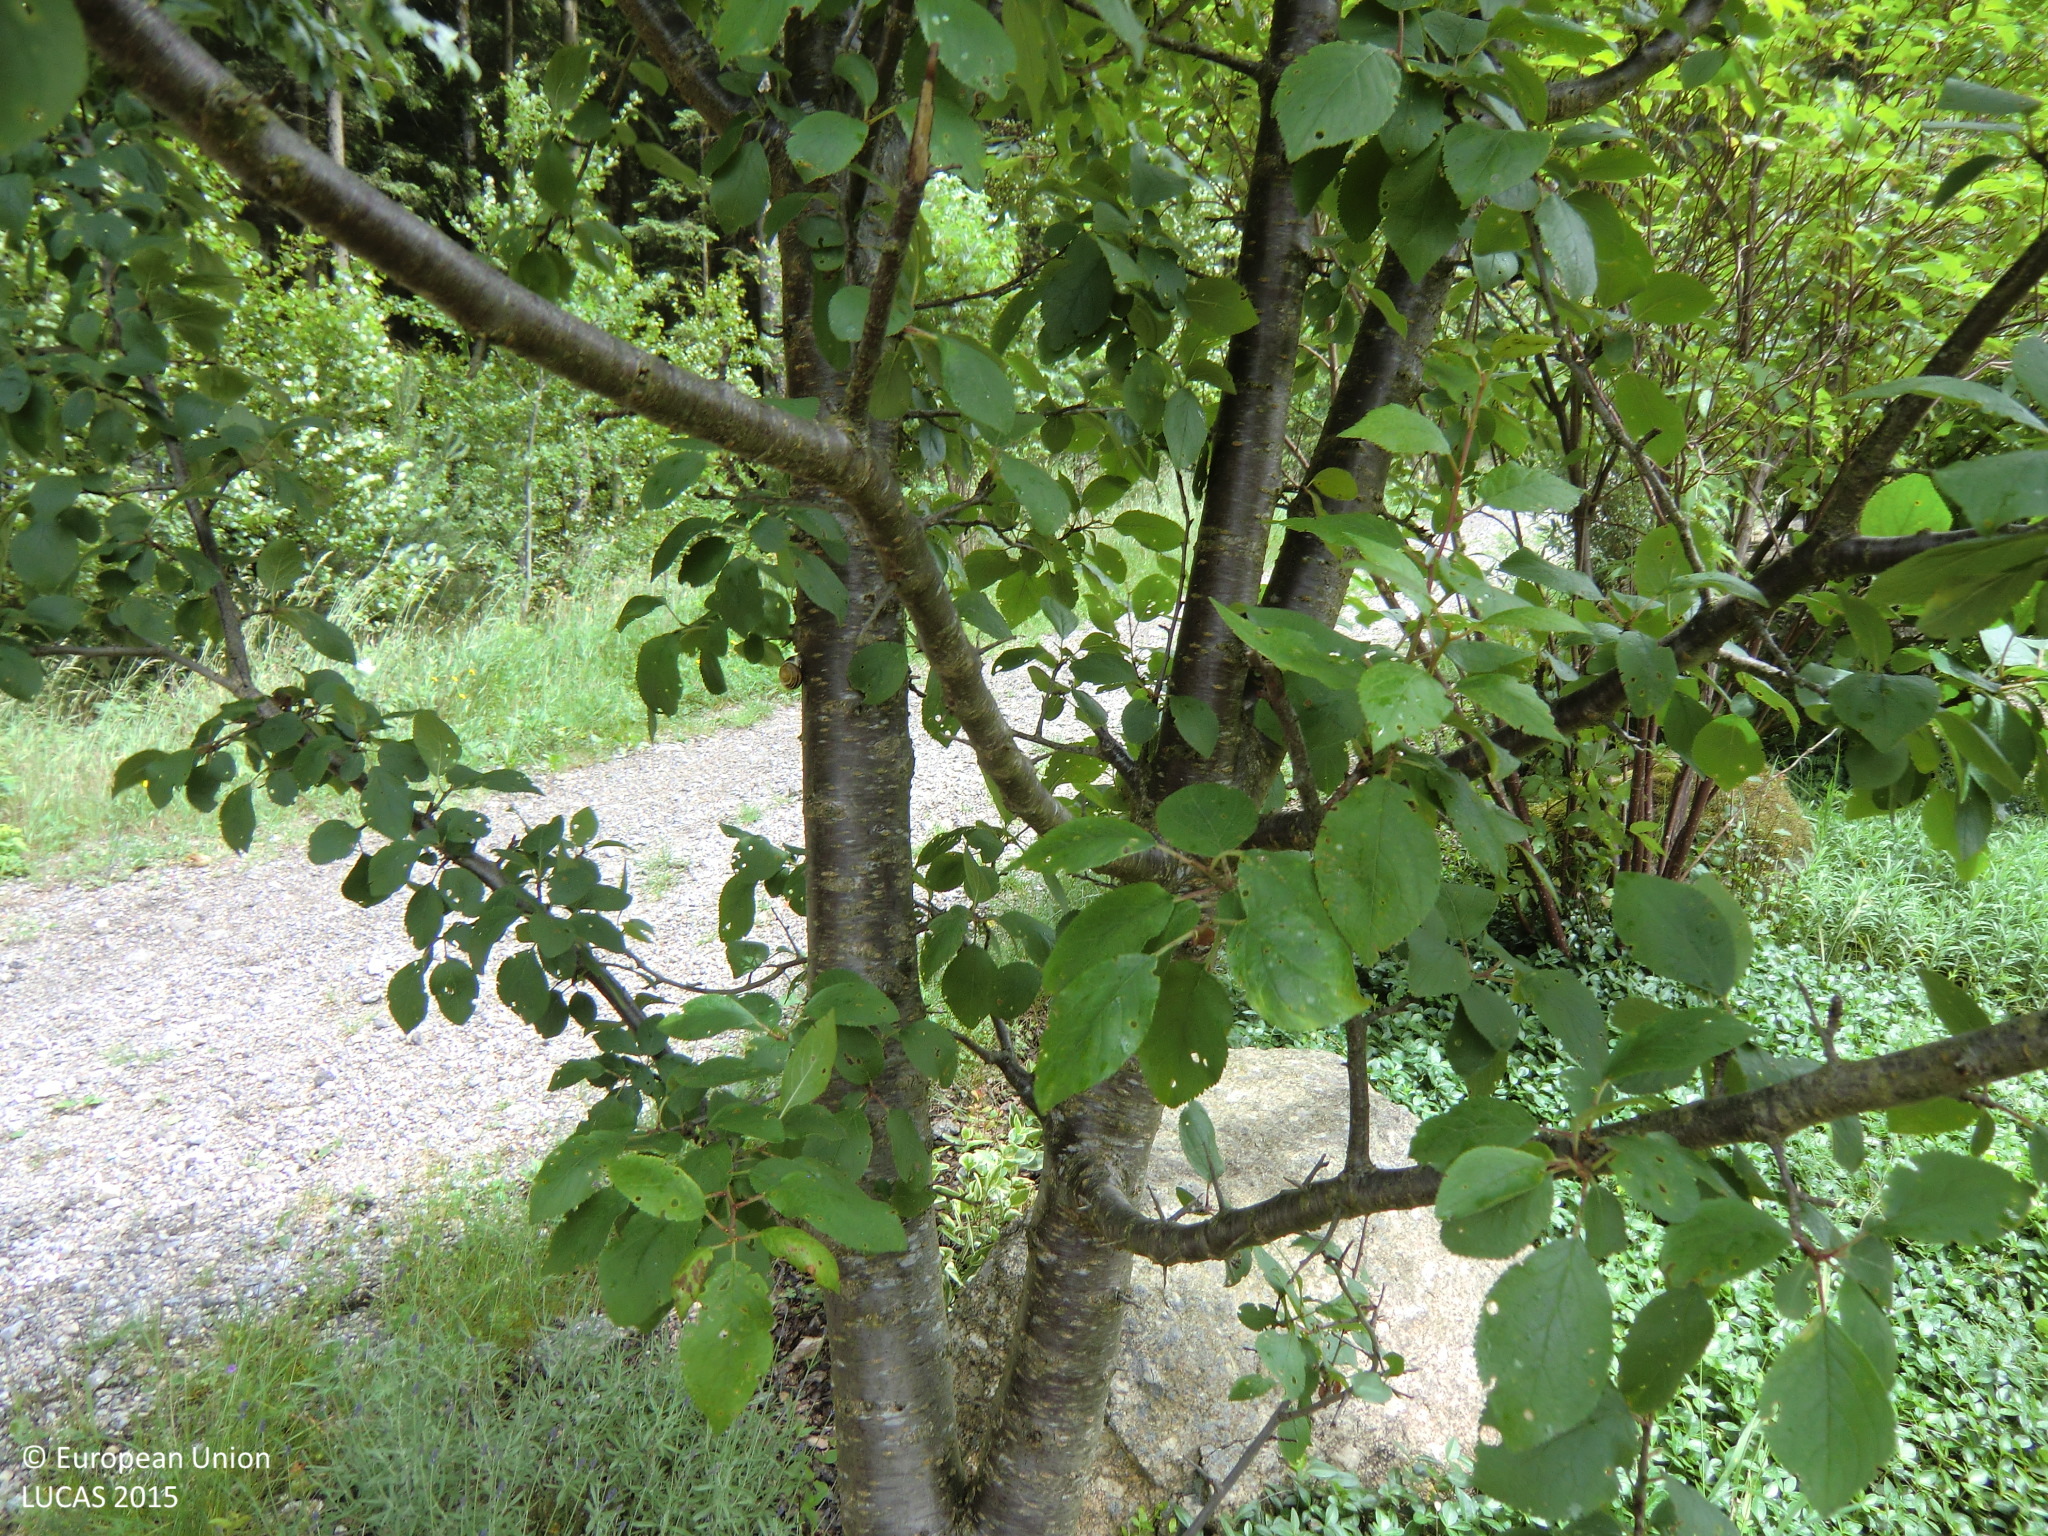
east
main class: Woodland
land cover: Broadleaved woodland
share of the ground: 50 - 75 %
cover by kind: broadleaved forest trees 65 %, herbaceous plants 25 %, unconsolidated bare surface 10 %
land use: Semi-natural and natural areas not in use
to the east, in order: Broadleaved woodland; Tracks; Grassland without tree/shrub cover; Spruce dominated mixed woodland; Spruce dominated coniferous woodland; Tracks; Spruce dominated coniferous woodland; Tracks; Spruce dominated coniferous woodland; Tracks; Spruce dominated coniferous woodland; Tracks; Spruce dominated coniferous woodland
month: June
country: AT
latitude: 48.4506
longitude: 15.0448
